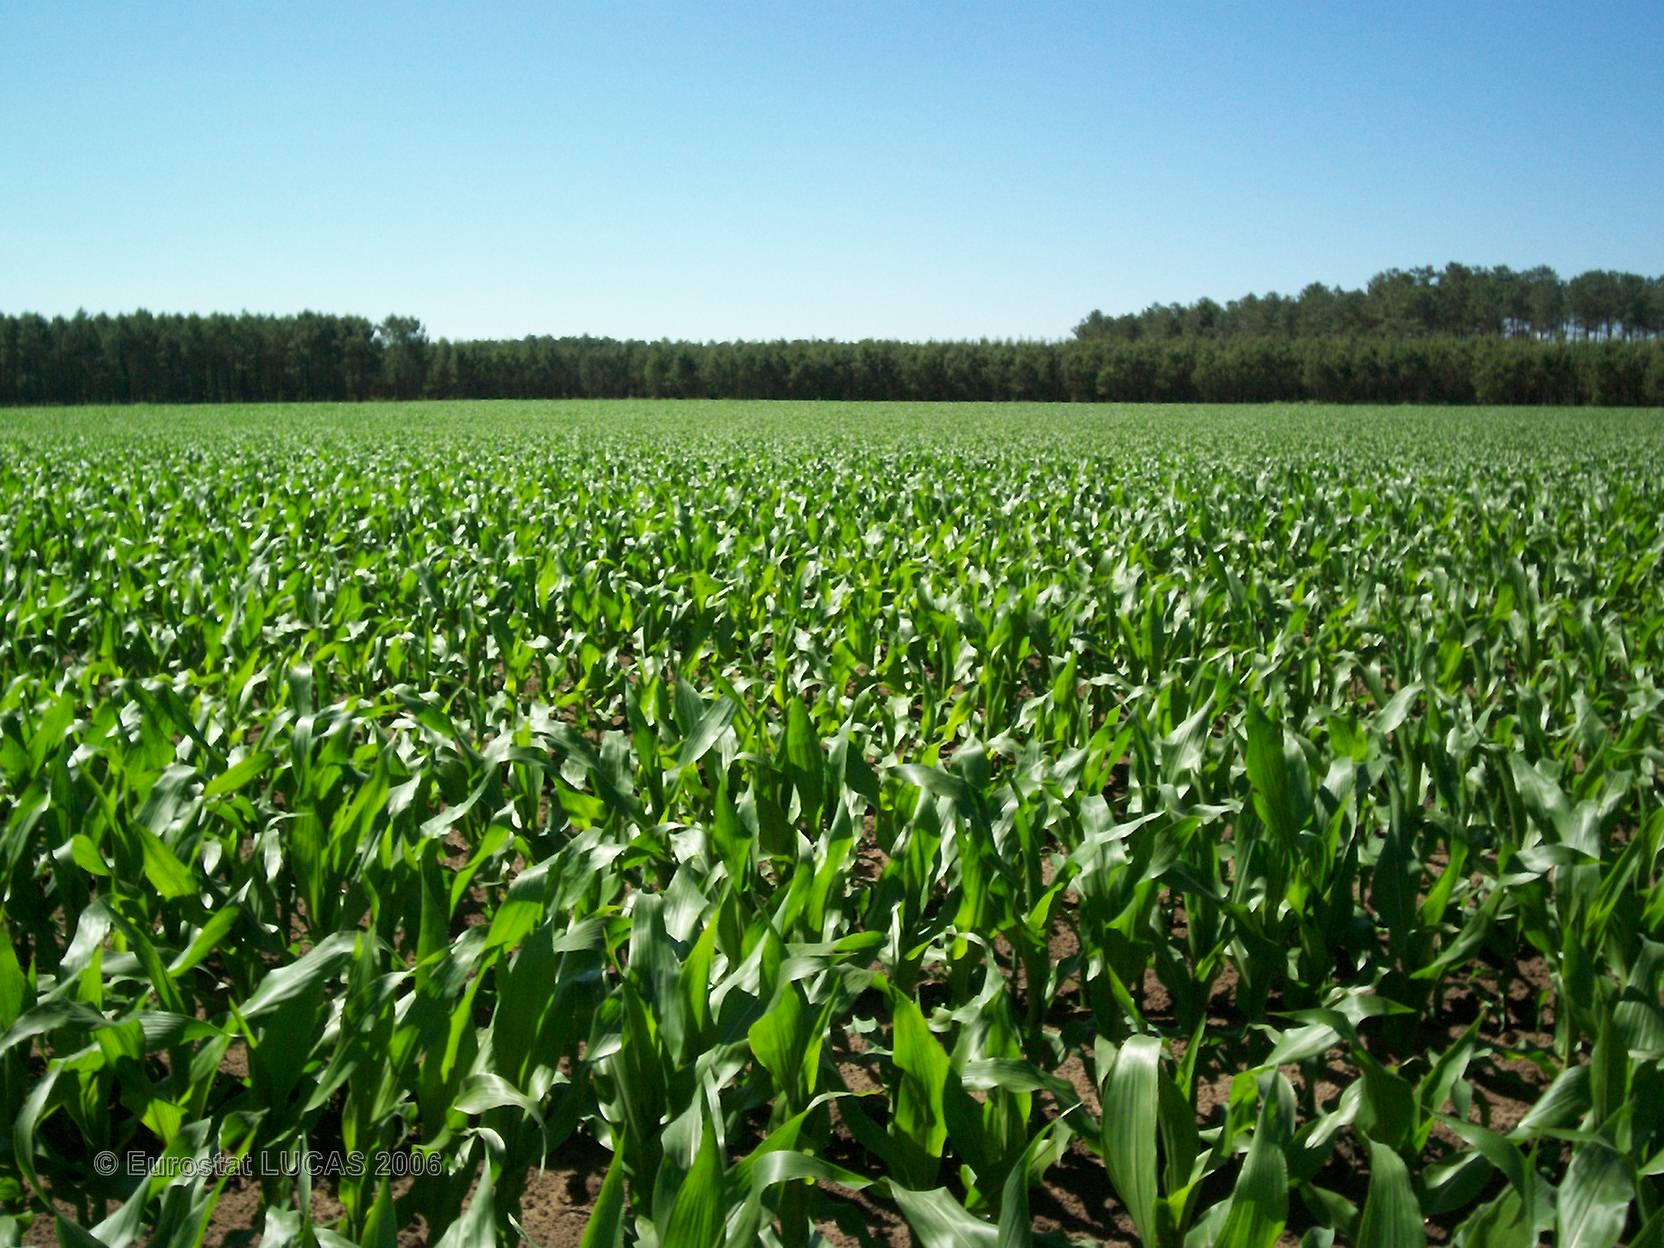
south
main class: Cropland
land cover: Maize
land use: Agriculture (excluding fallow land and kitchen gardens)
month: June
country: FR
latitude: 43.9803
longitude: -0.4970
